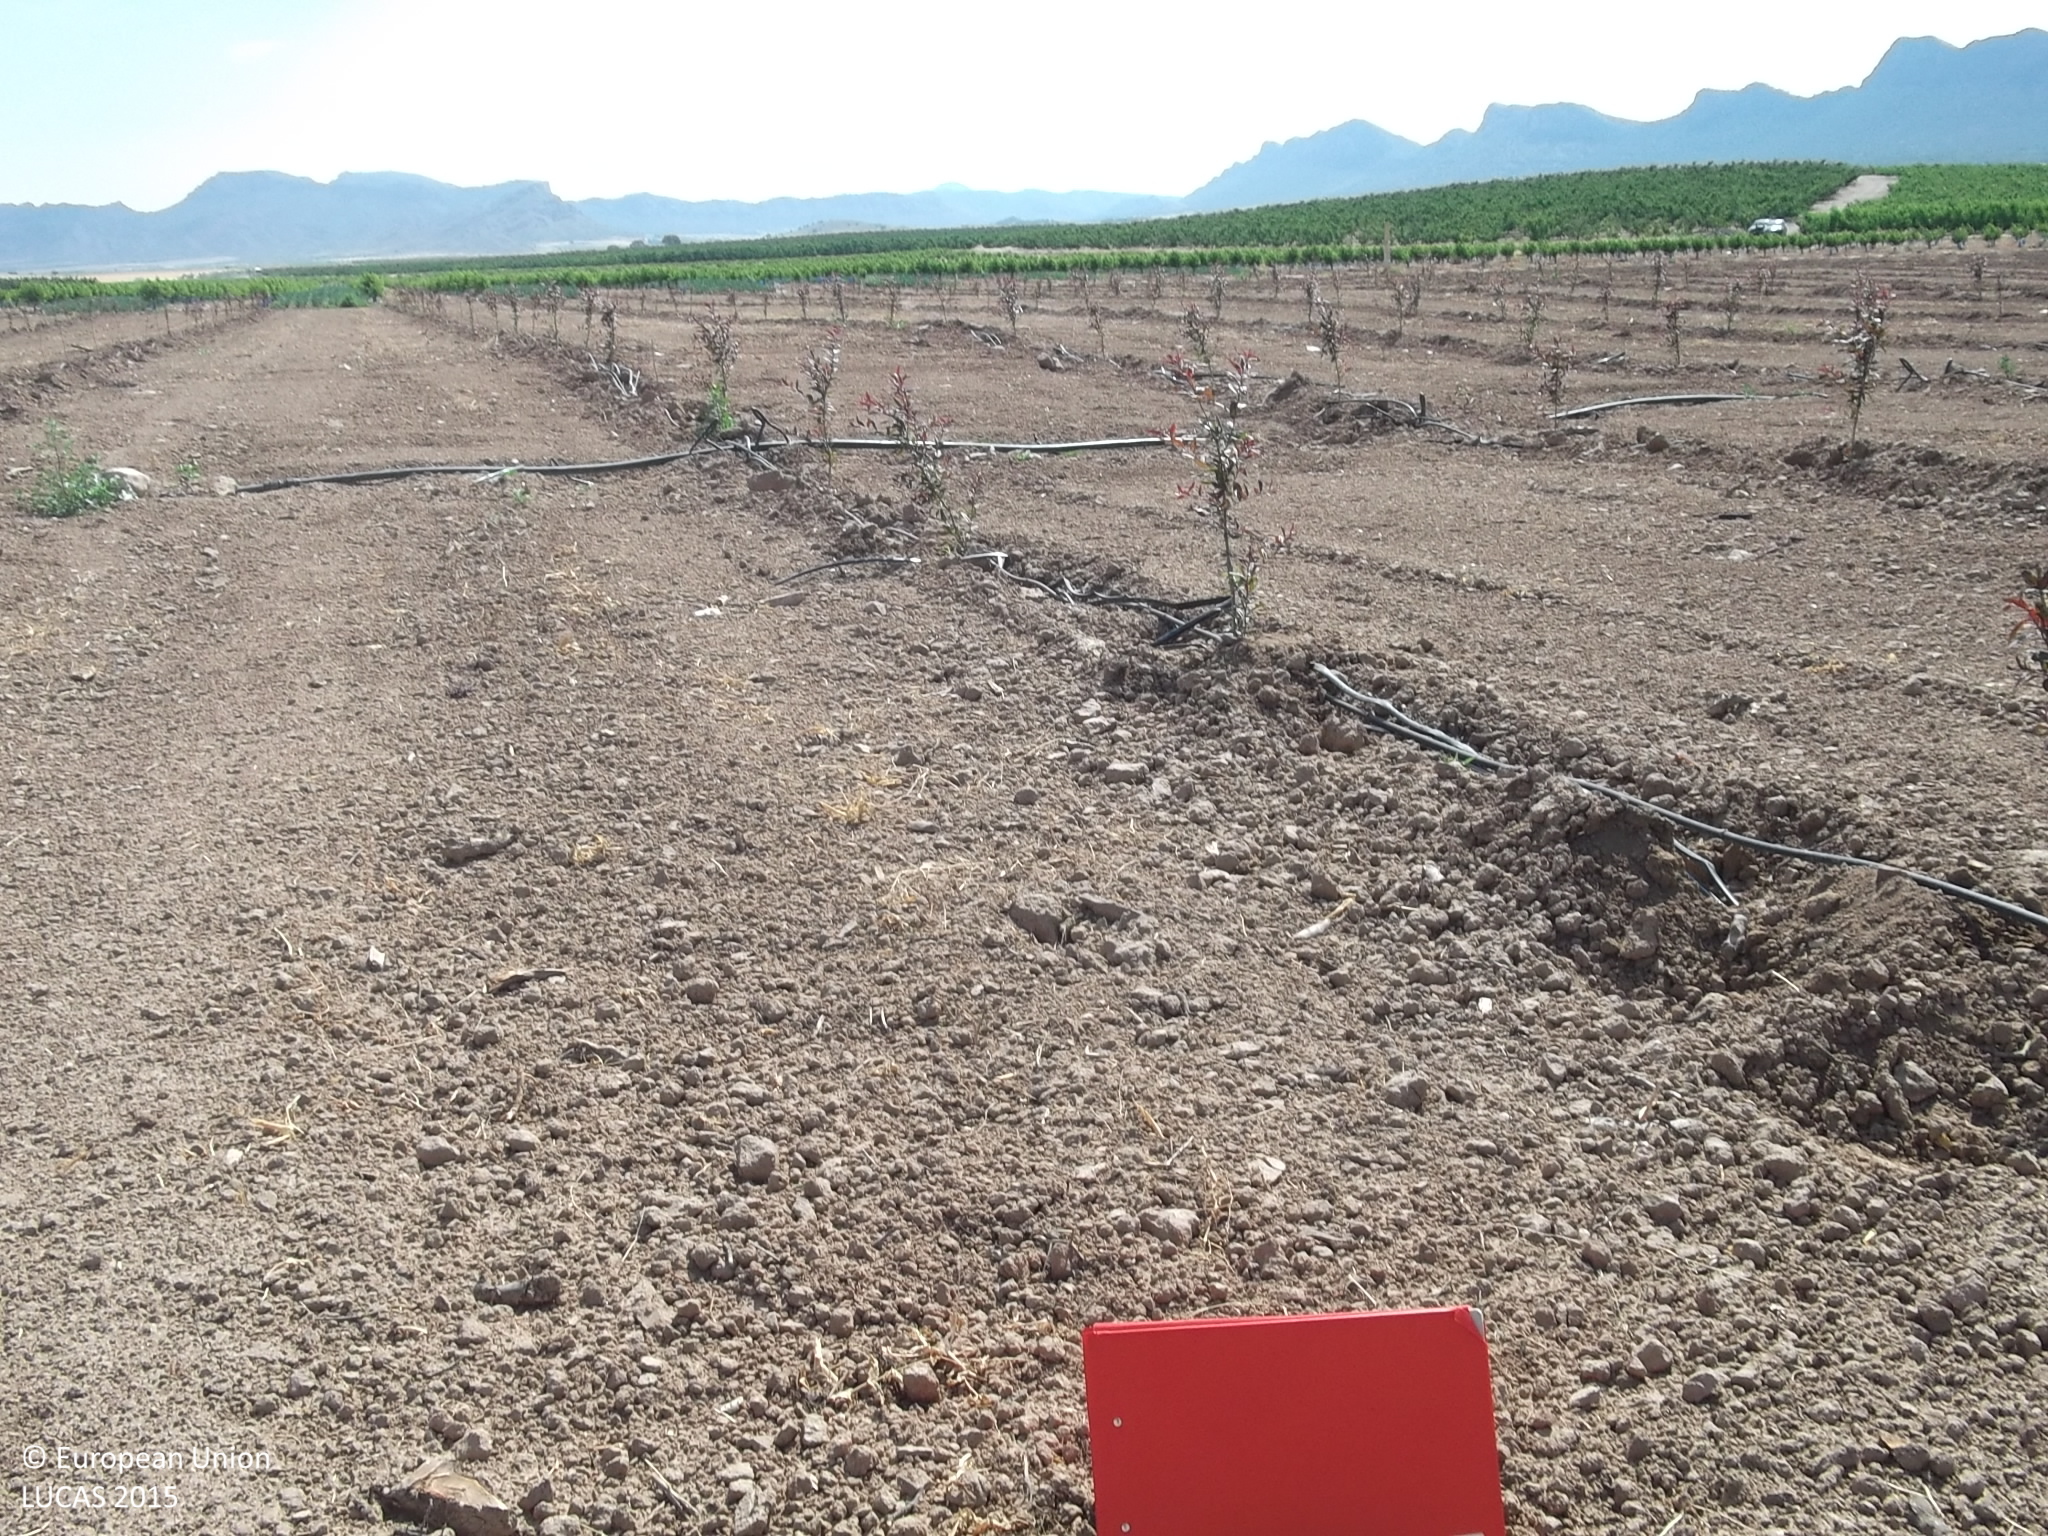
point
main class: Cropland
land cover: Other fruit trees and berries
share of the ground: < 10 %
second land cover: Other bare soil
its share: > 75 %
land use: Agriculture (excluding fallow land and kitchen gardens)
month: June
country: ES
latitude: 38.3736
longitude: -1.4250
